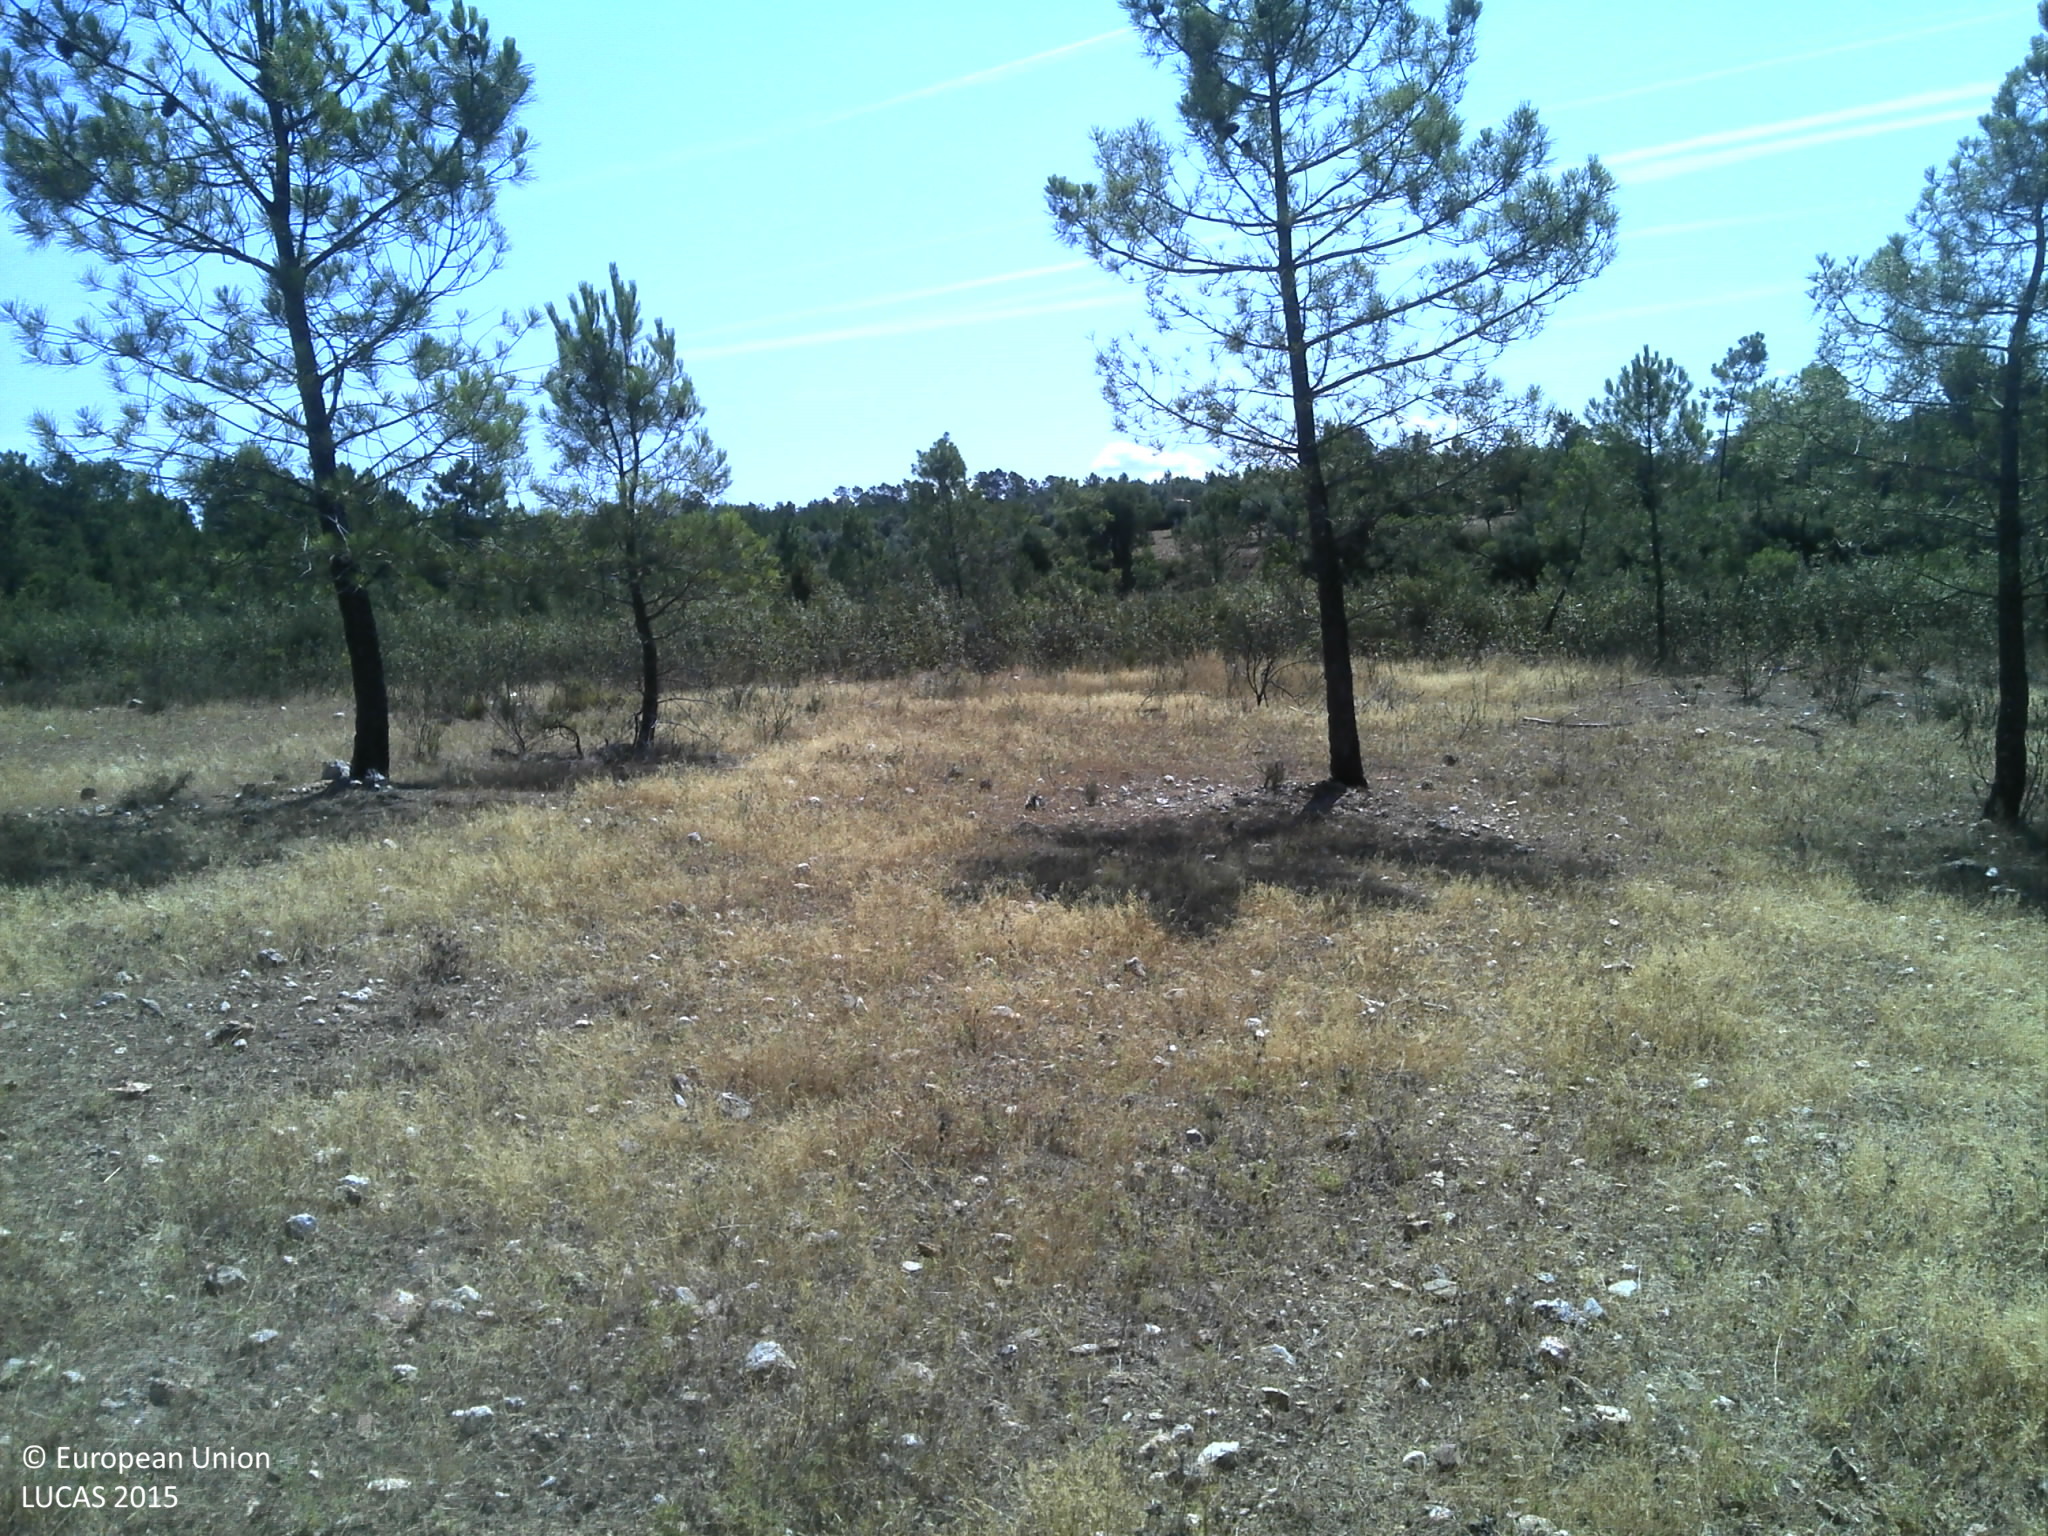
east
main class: Grassland
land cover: Grassland without tree/shrub cover
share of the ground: 25 - 50 %
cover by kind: unconsolidated bare surface 75 %, herbaceous plants 25 %
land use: Agriculture (excluding fallow land and kitchen gardens)
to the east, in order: Grassland without tree/shrub cover; Pine dominated coniferous woodland; Shrubland with sparse tree cover; Fences; Tracks; Shrubland with sparse tree cover; Dry stone walls; Grassland without tree/shrub cover; Shrubland without tree cover; Dry stone walls; Olive groves; Dry stone walls; Olive groves; Dry stone walls; Fences; Grassland without tree/shrub cover; Olive groves
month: July
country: PT
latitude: 39.7523
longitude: -7.5954
